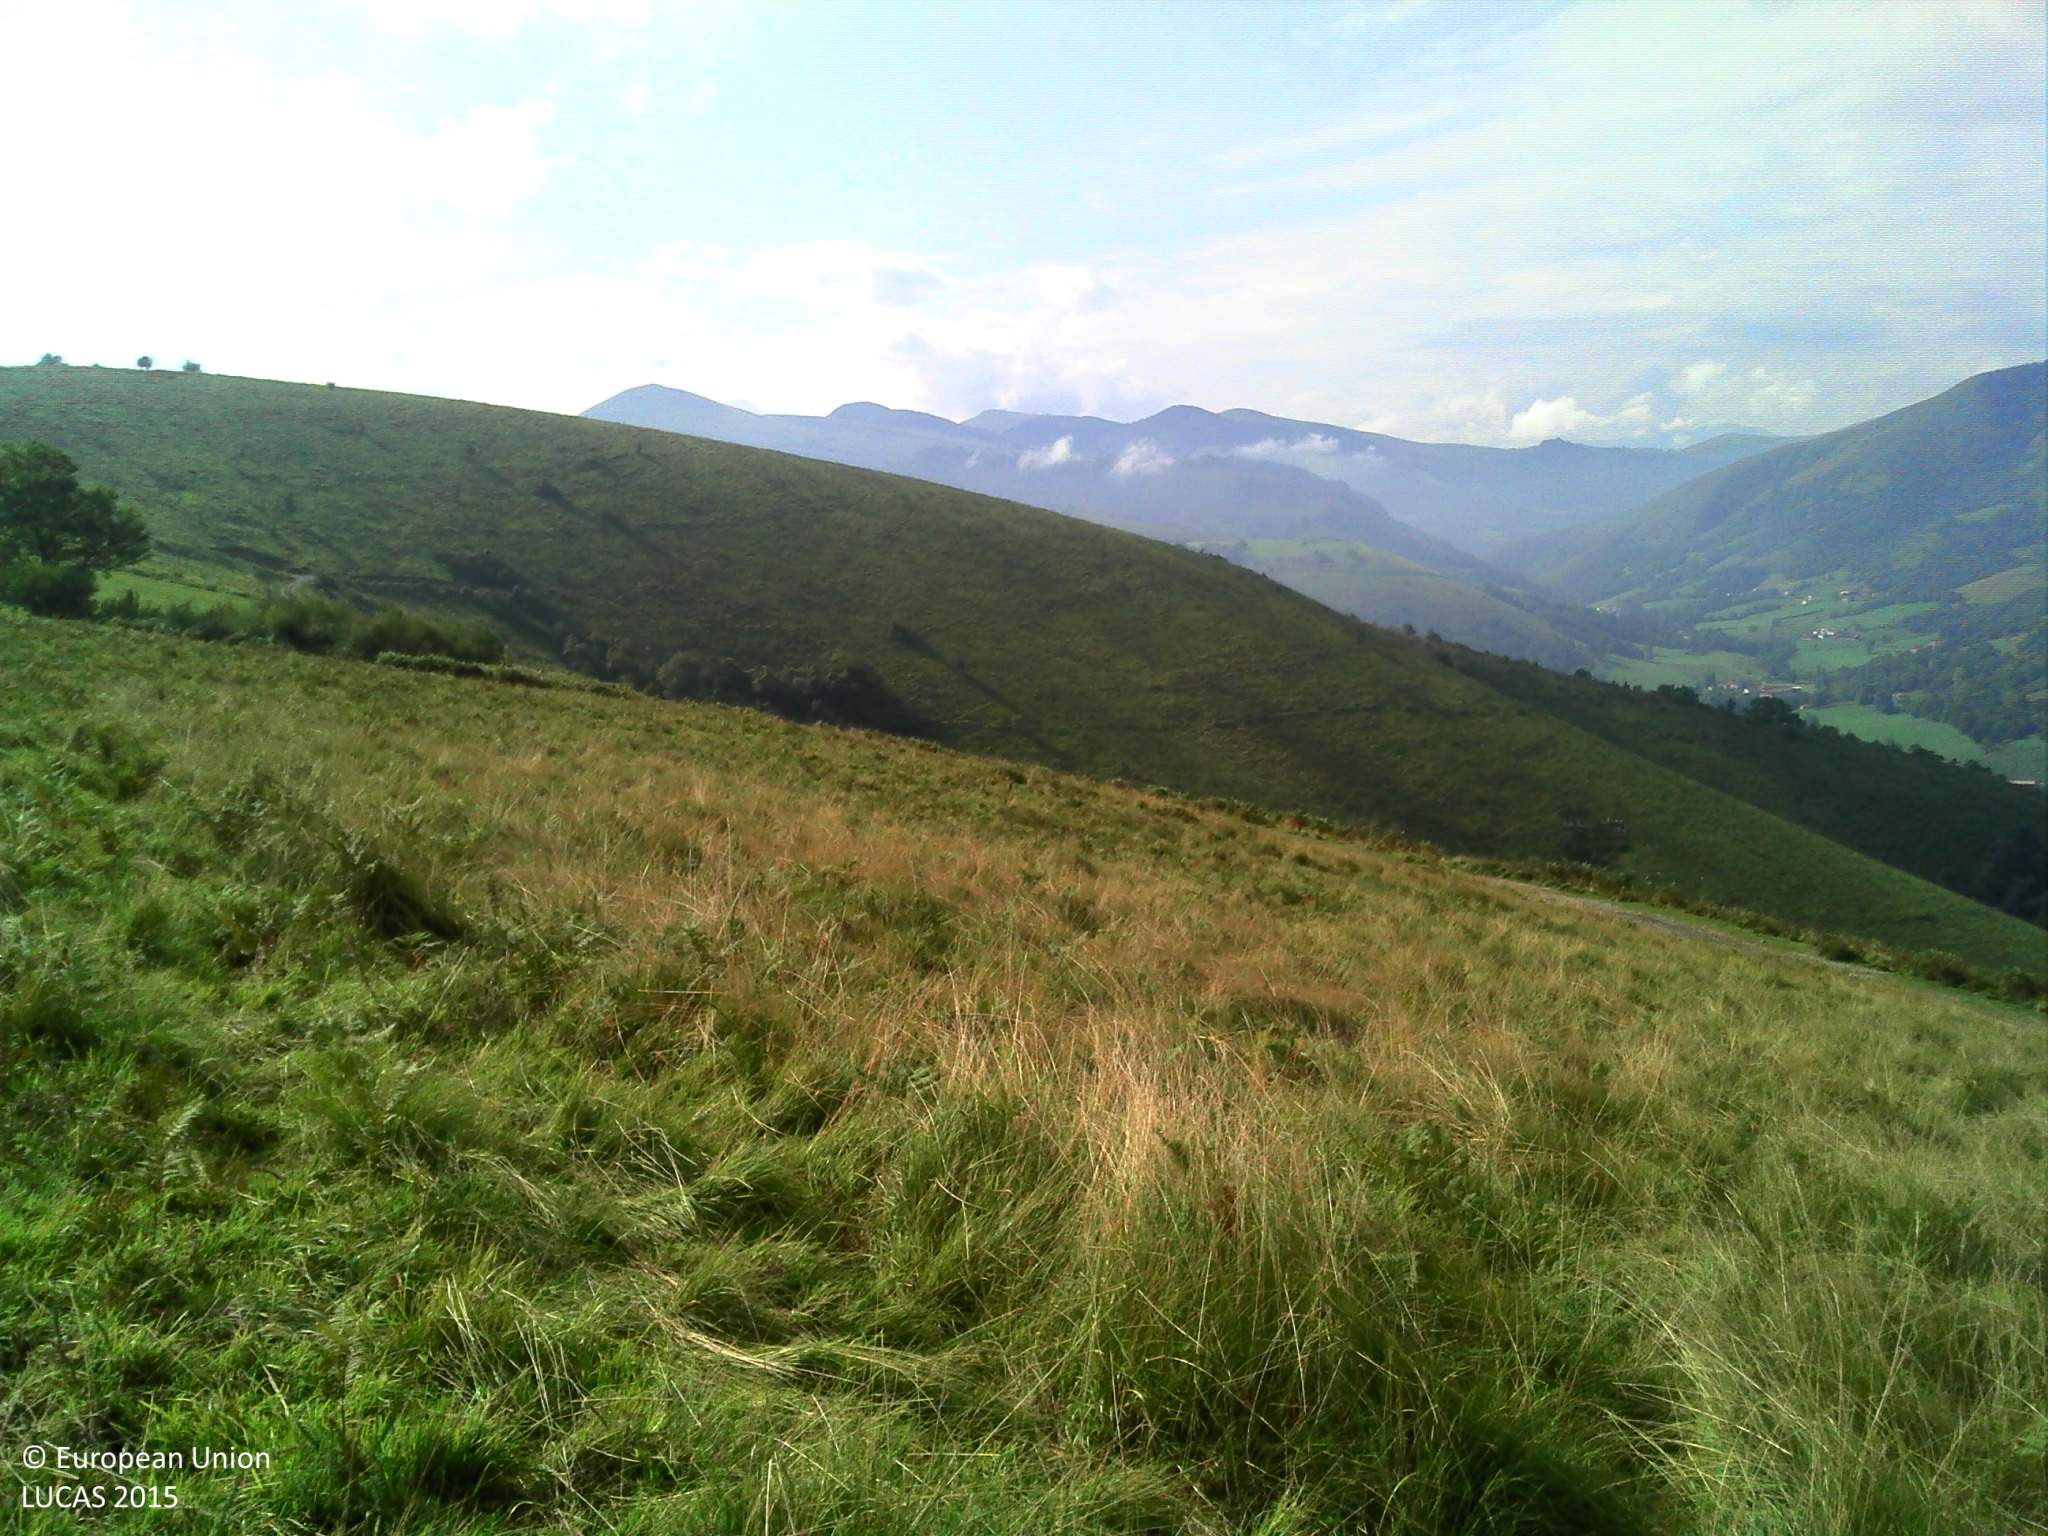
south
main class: Grassland
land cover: Grassland without tree/shrub cover
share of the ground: > 75 %
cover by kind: herbaceous plants 95 %, shrubs 5 %
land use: Agriculture (excluding fallow land and kitchen gardens)
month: September
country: FR
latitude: 43.2123
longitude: -1.0534
